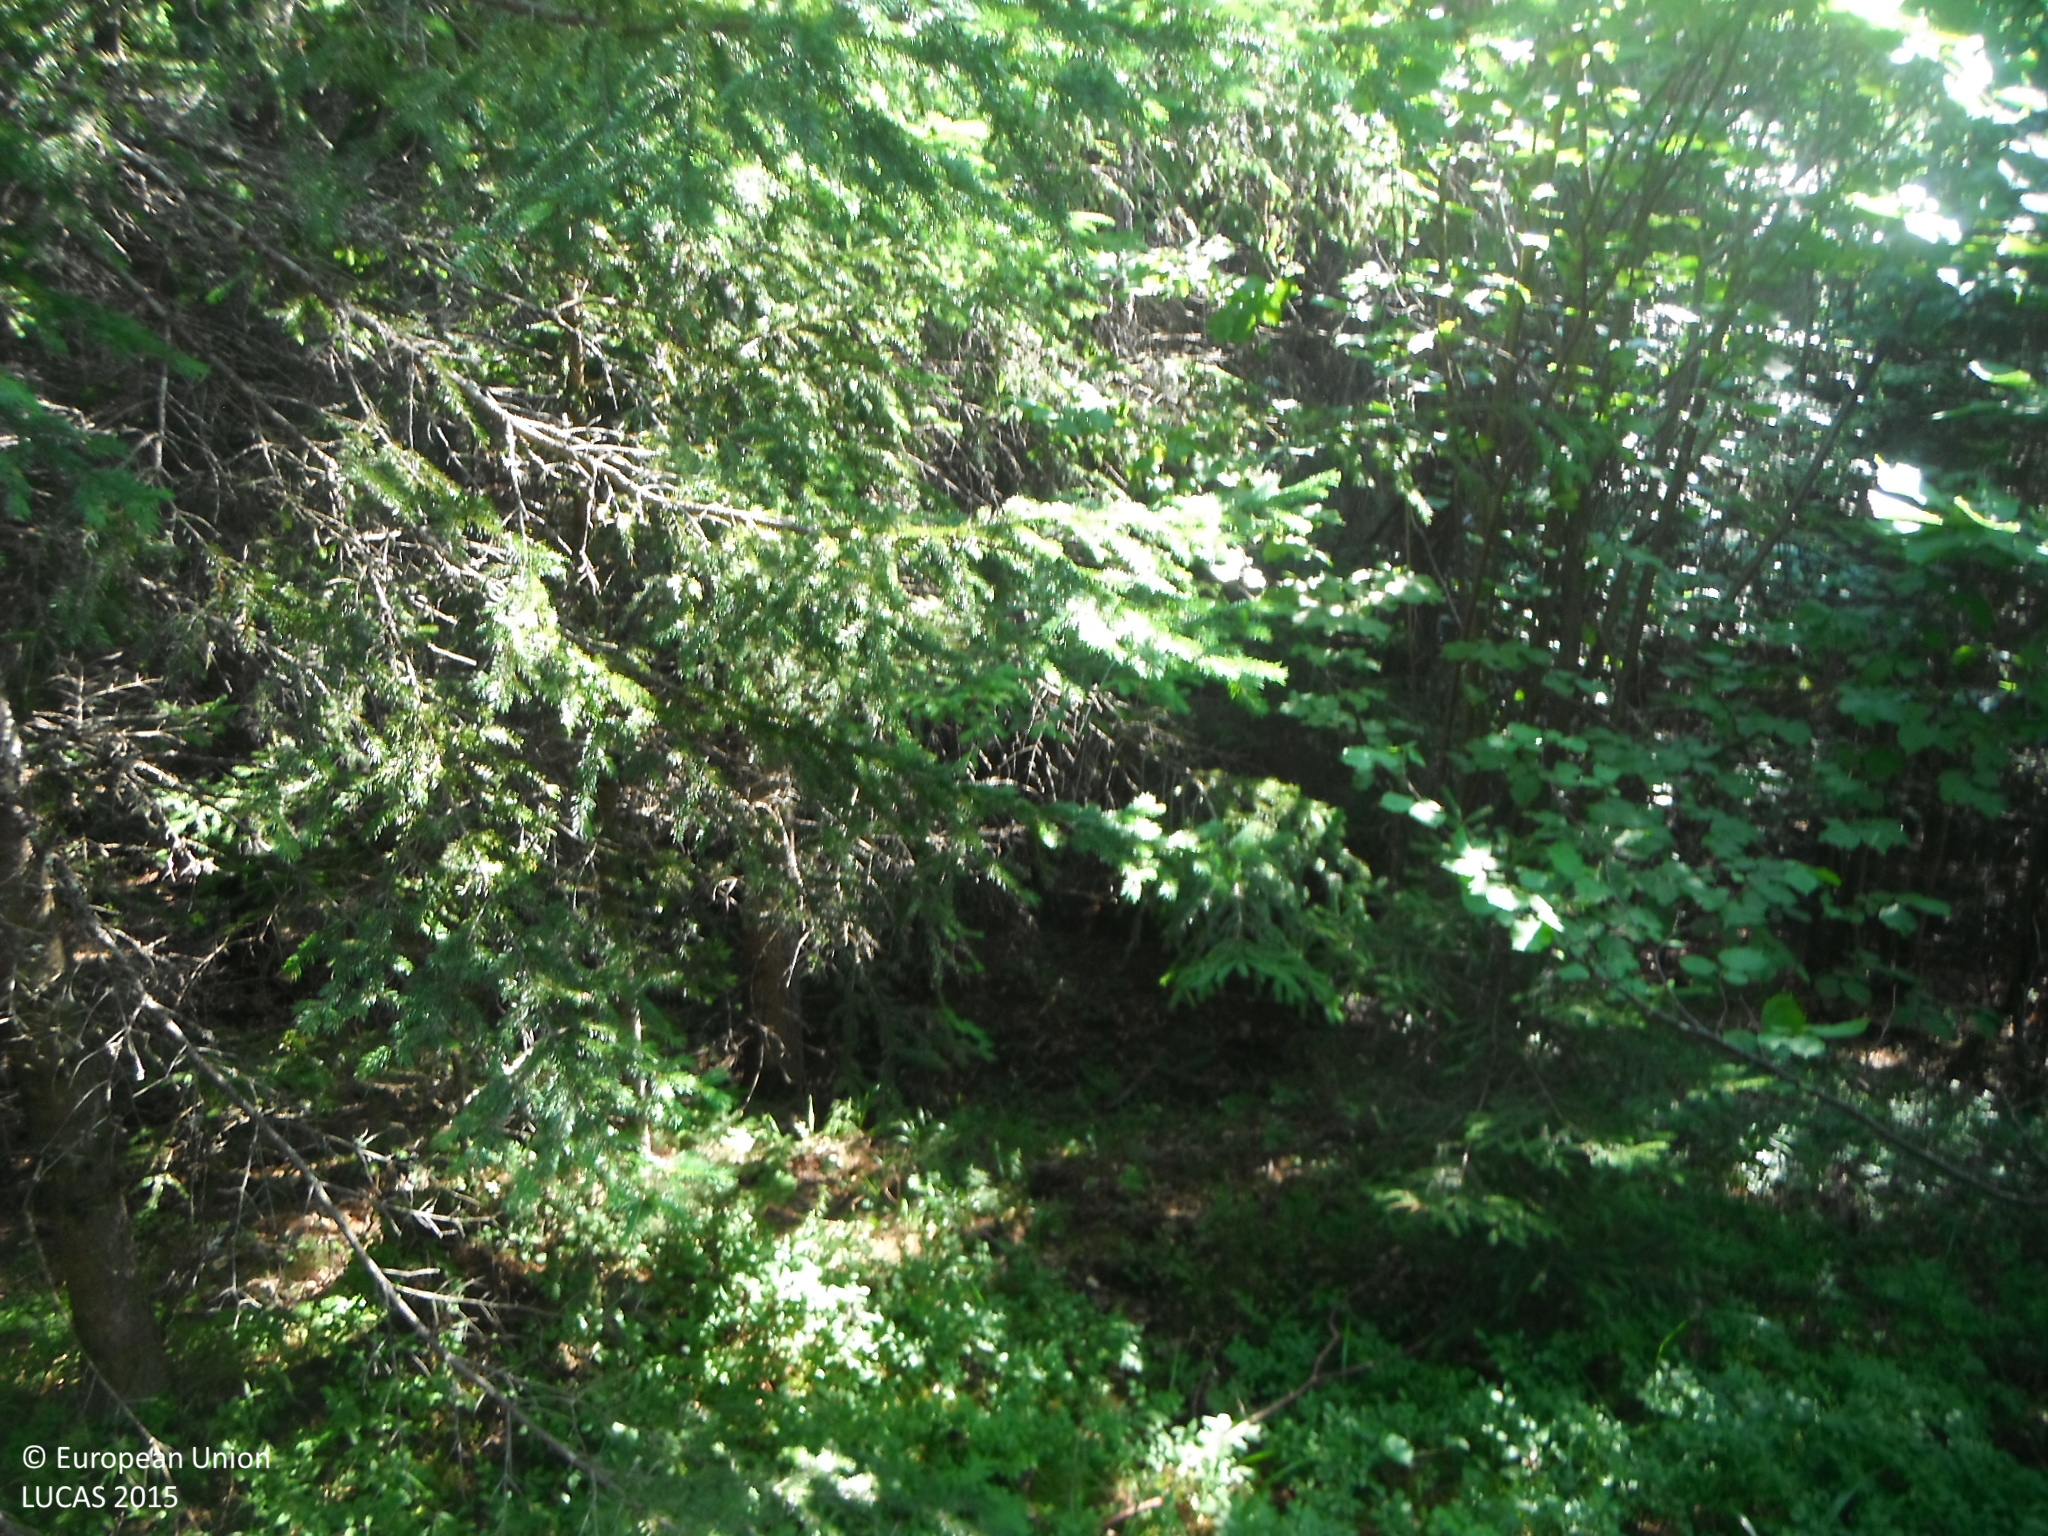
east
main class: Woodland
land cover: Spruce dominated mixed woodland
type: hemiboreal forest and nemoral coniferous forest and mixed broadleaved-coniferous forest
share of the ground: > 75 %
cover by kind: coniferous forest trees 60 %, broadleaved forest trees 40 %
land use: Forestry
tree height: > 5 m
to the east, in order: Spruce dominated mixed woodland; Grassland without tree/shrub cover; Shrubland without tree cover; Grassland without tree/shrub cover
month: July
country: SK
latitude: 48.9228
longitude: 20.2554
